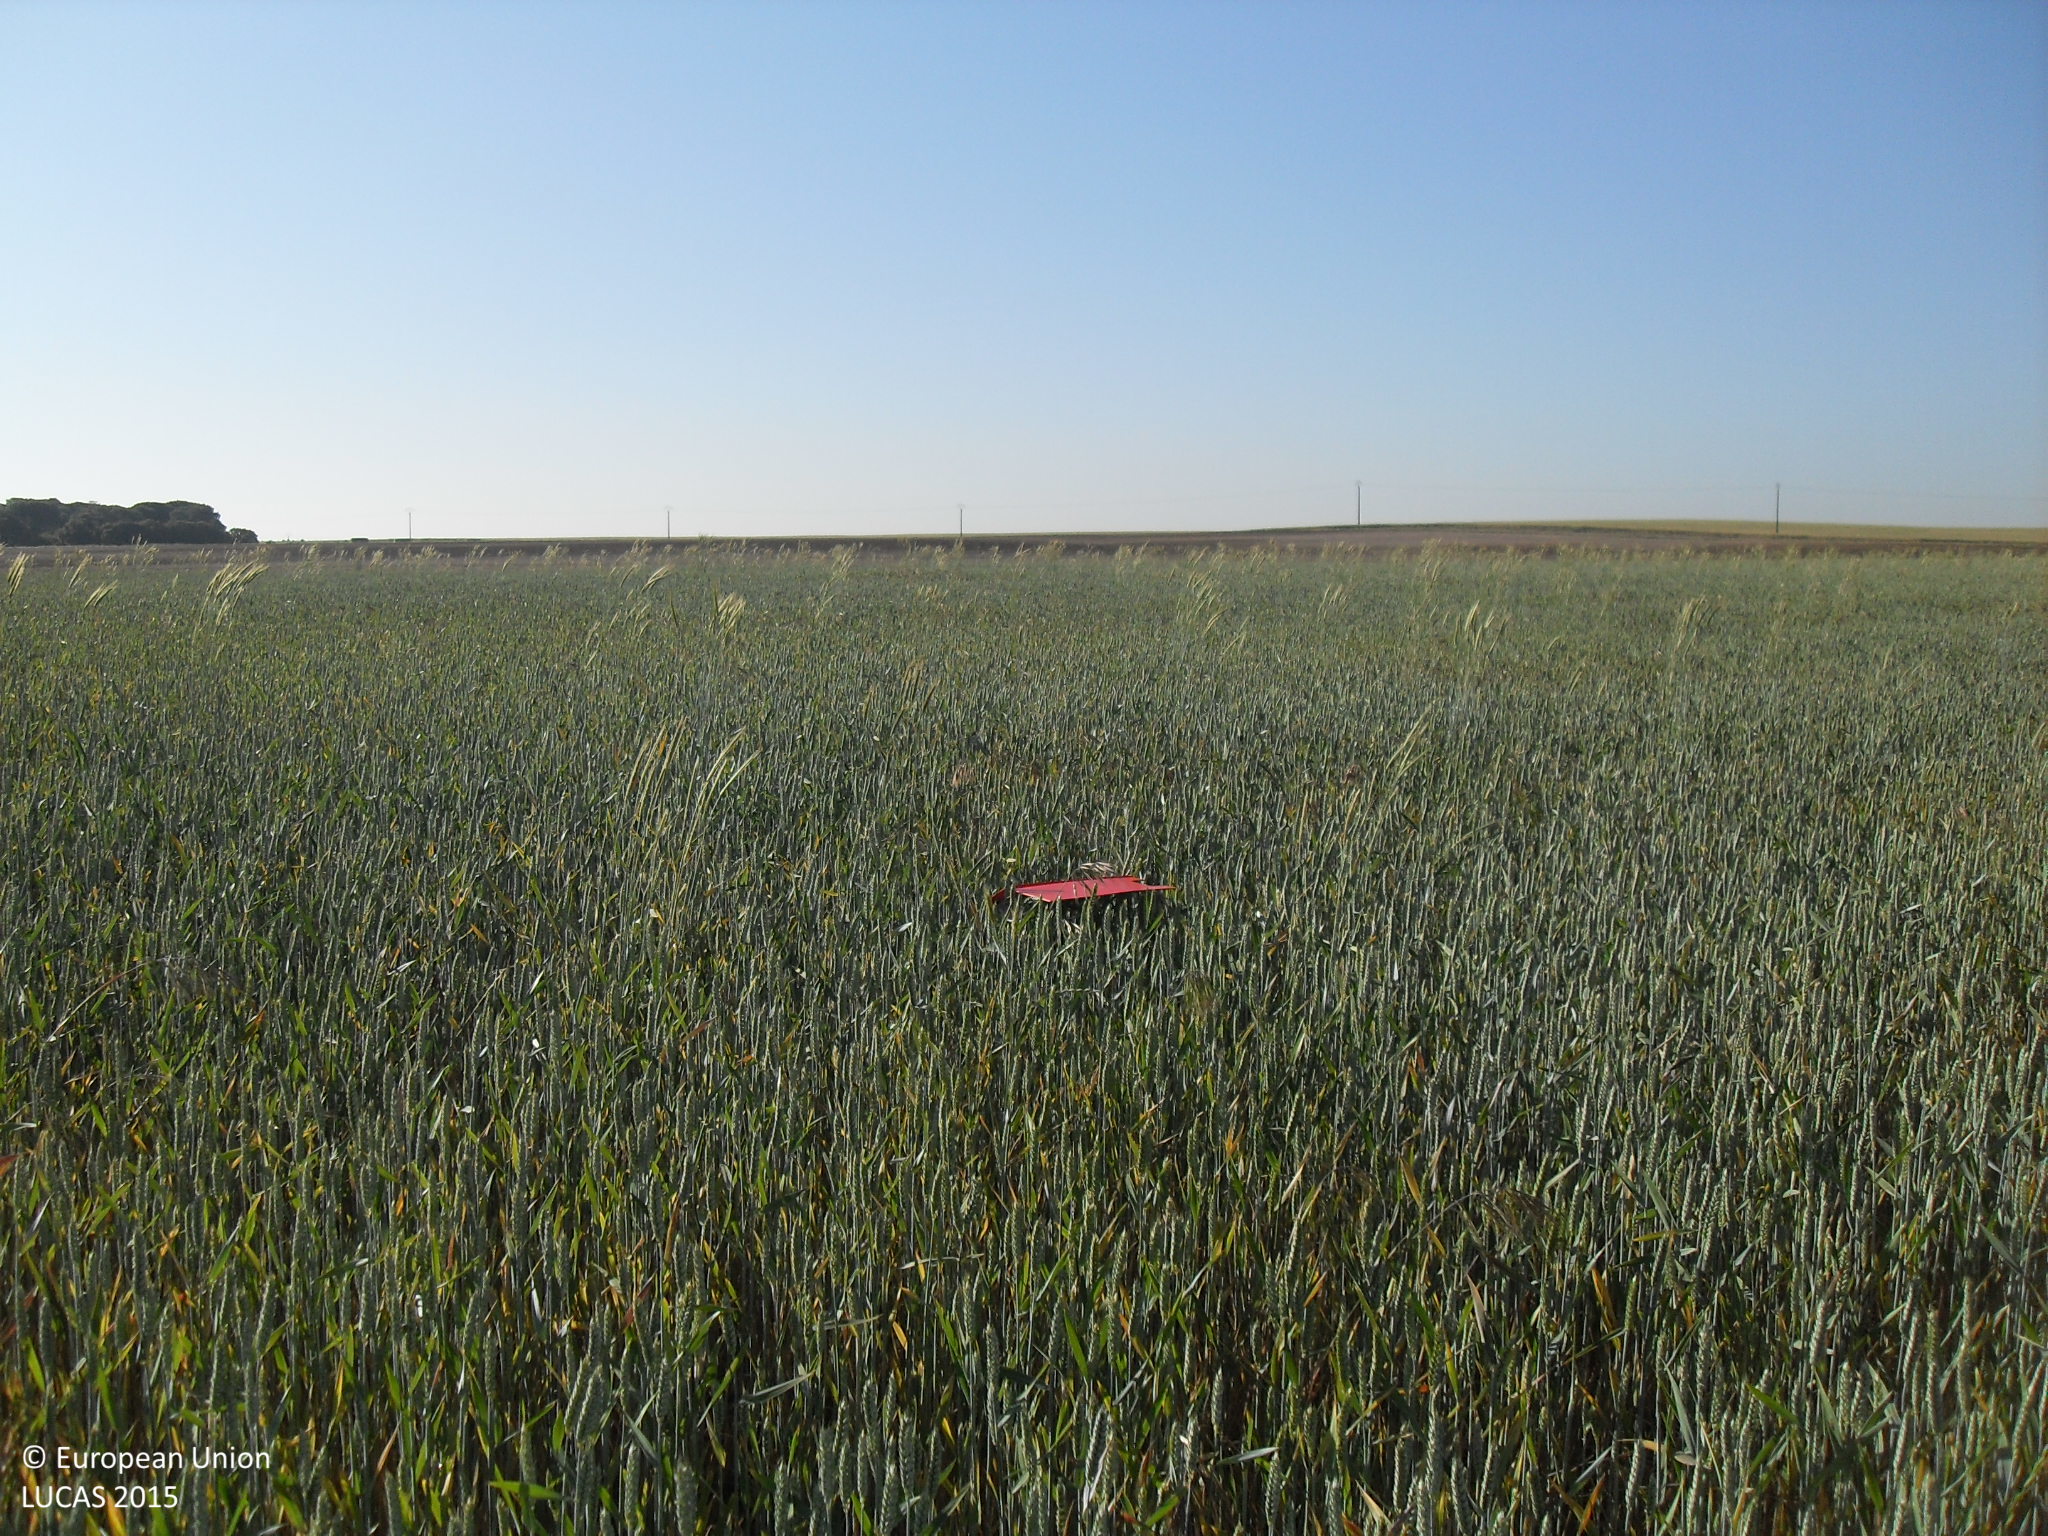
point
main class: Cropland
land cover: Common wheat
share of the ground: > 75 %
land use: Agriculture (excluding fallow land and kitchen gardens)
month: May
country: ES
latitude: 41.0774
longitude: -5.1979
